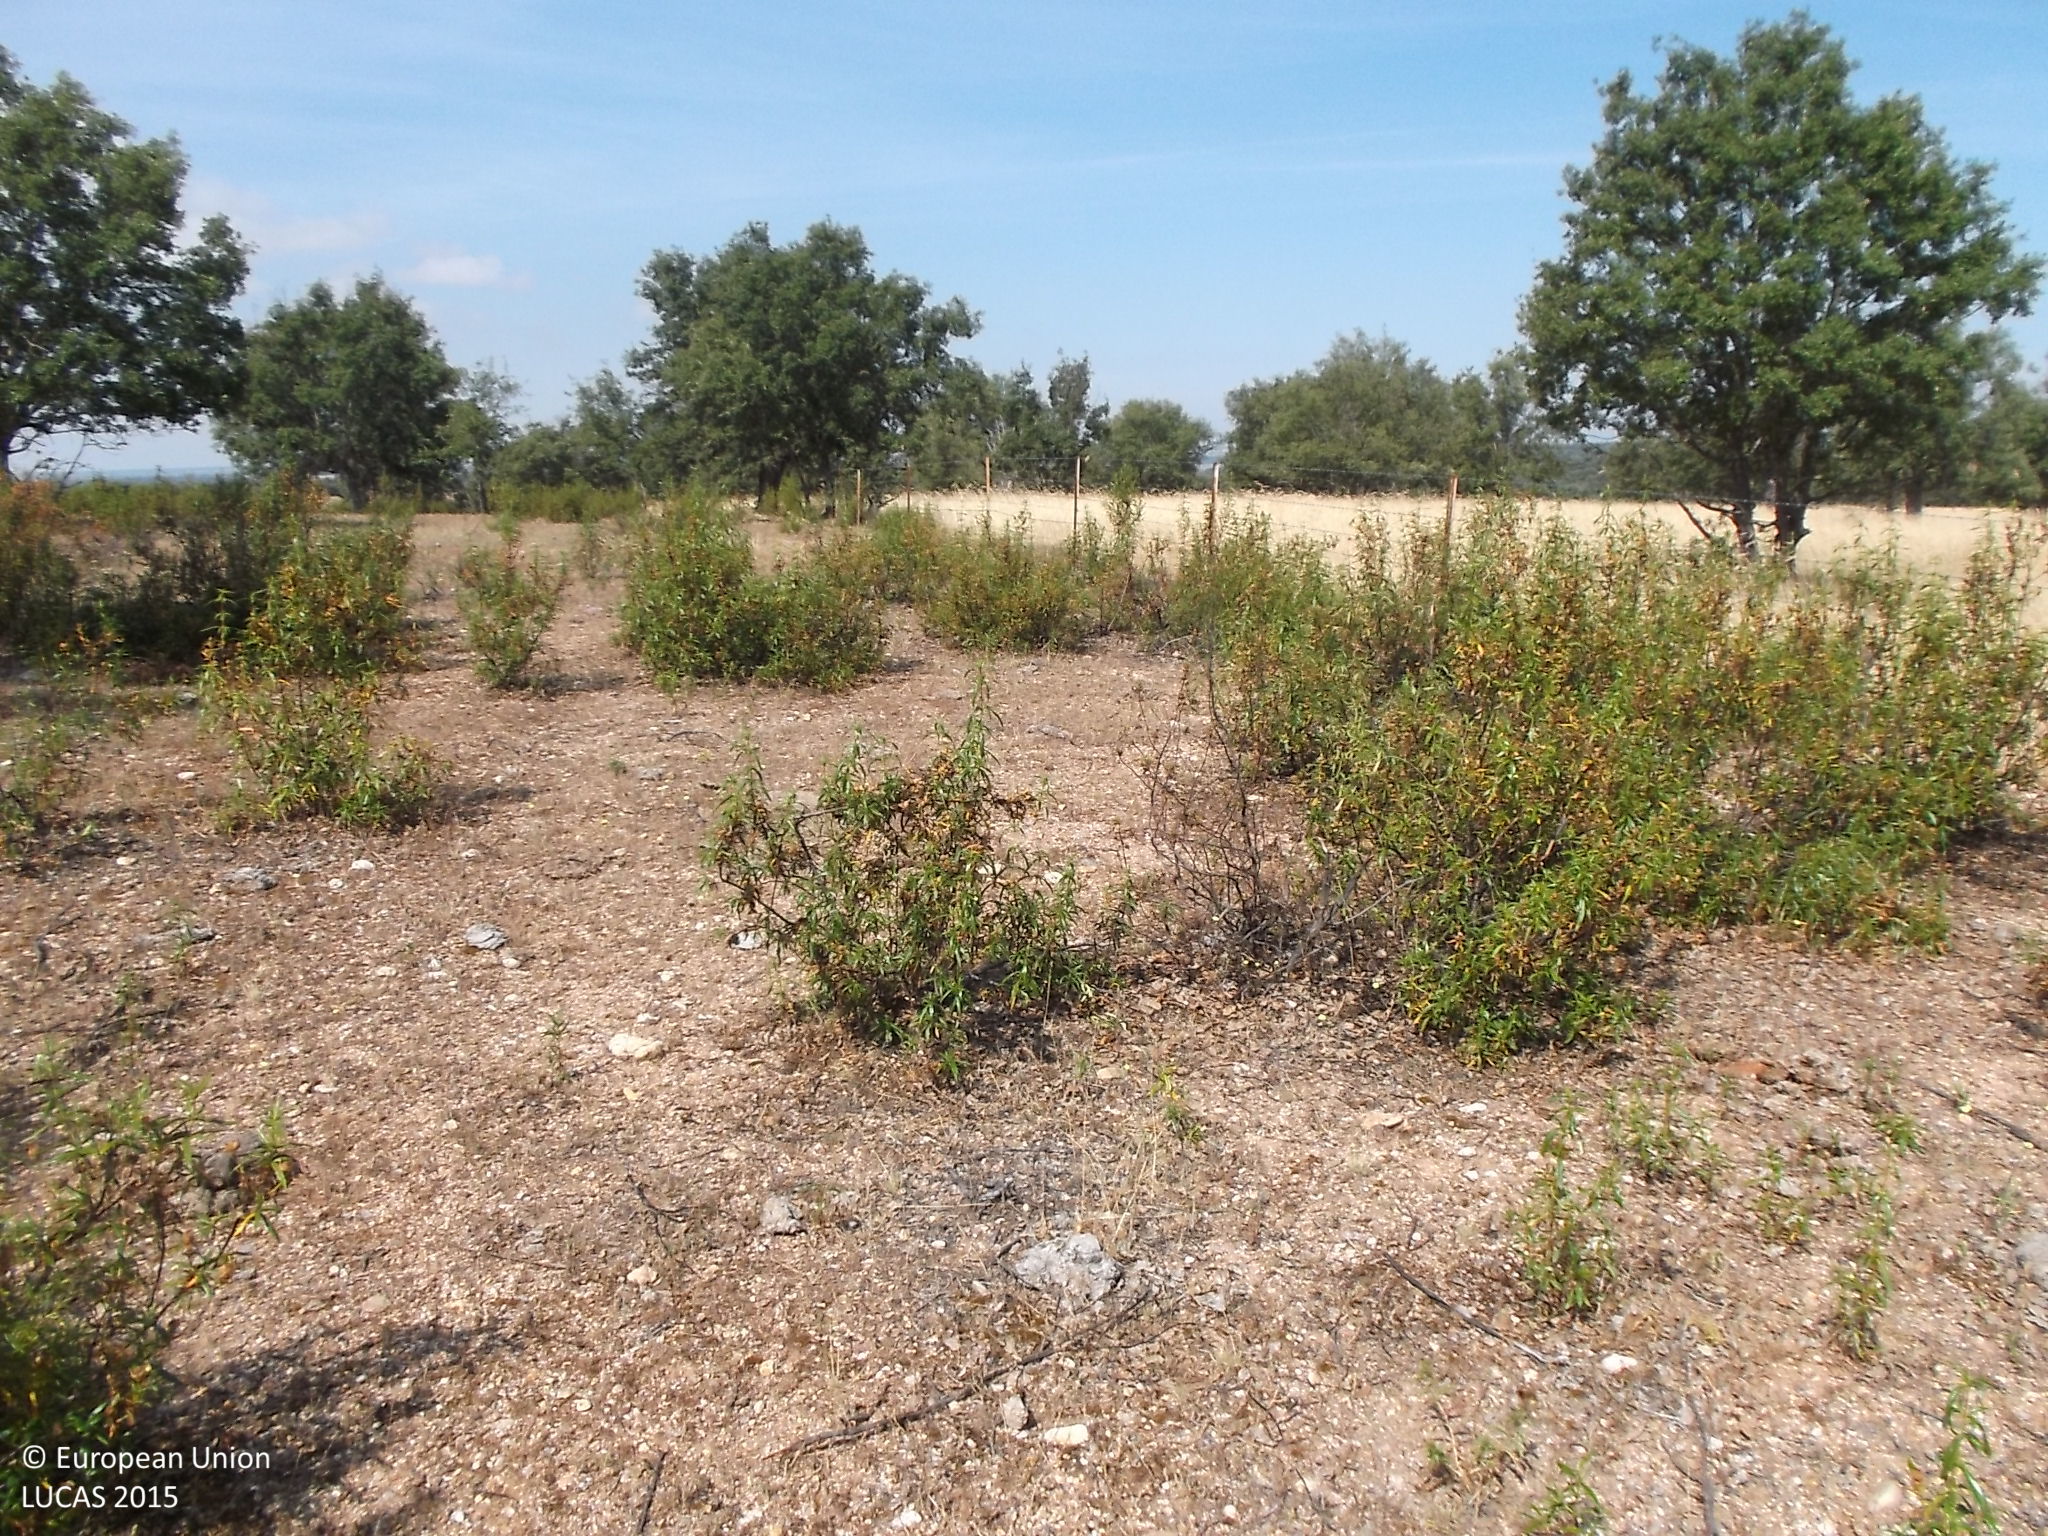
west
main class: Woodland
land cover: Broadleaved woodland
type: broadleaved evergreen forest
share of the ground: 10 - 25 %
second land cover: Grassland without tree/shrub cover
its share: 50 - 75 %
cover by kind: herbaceous plants 65 %, shrubs 20 %, broadleaved forest trees 15 %
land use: Forestry
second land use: Agriculture (excluding fallow land and kitchen gardens)
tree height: < 5 m
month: June
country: ES
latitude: 41.1842
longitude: -6.0271
